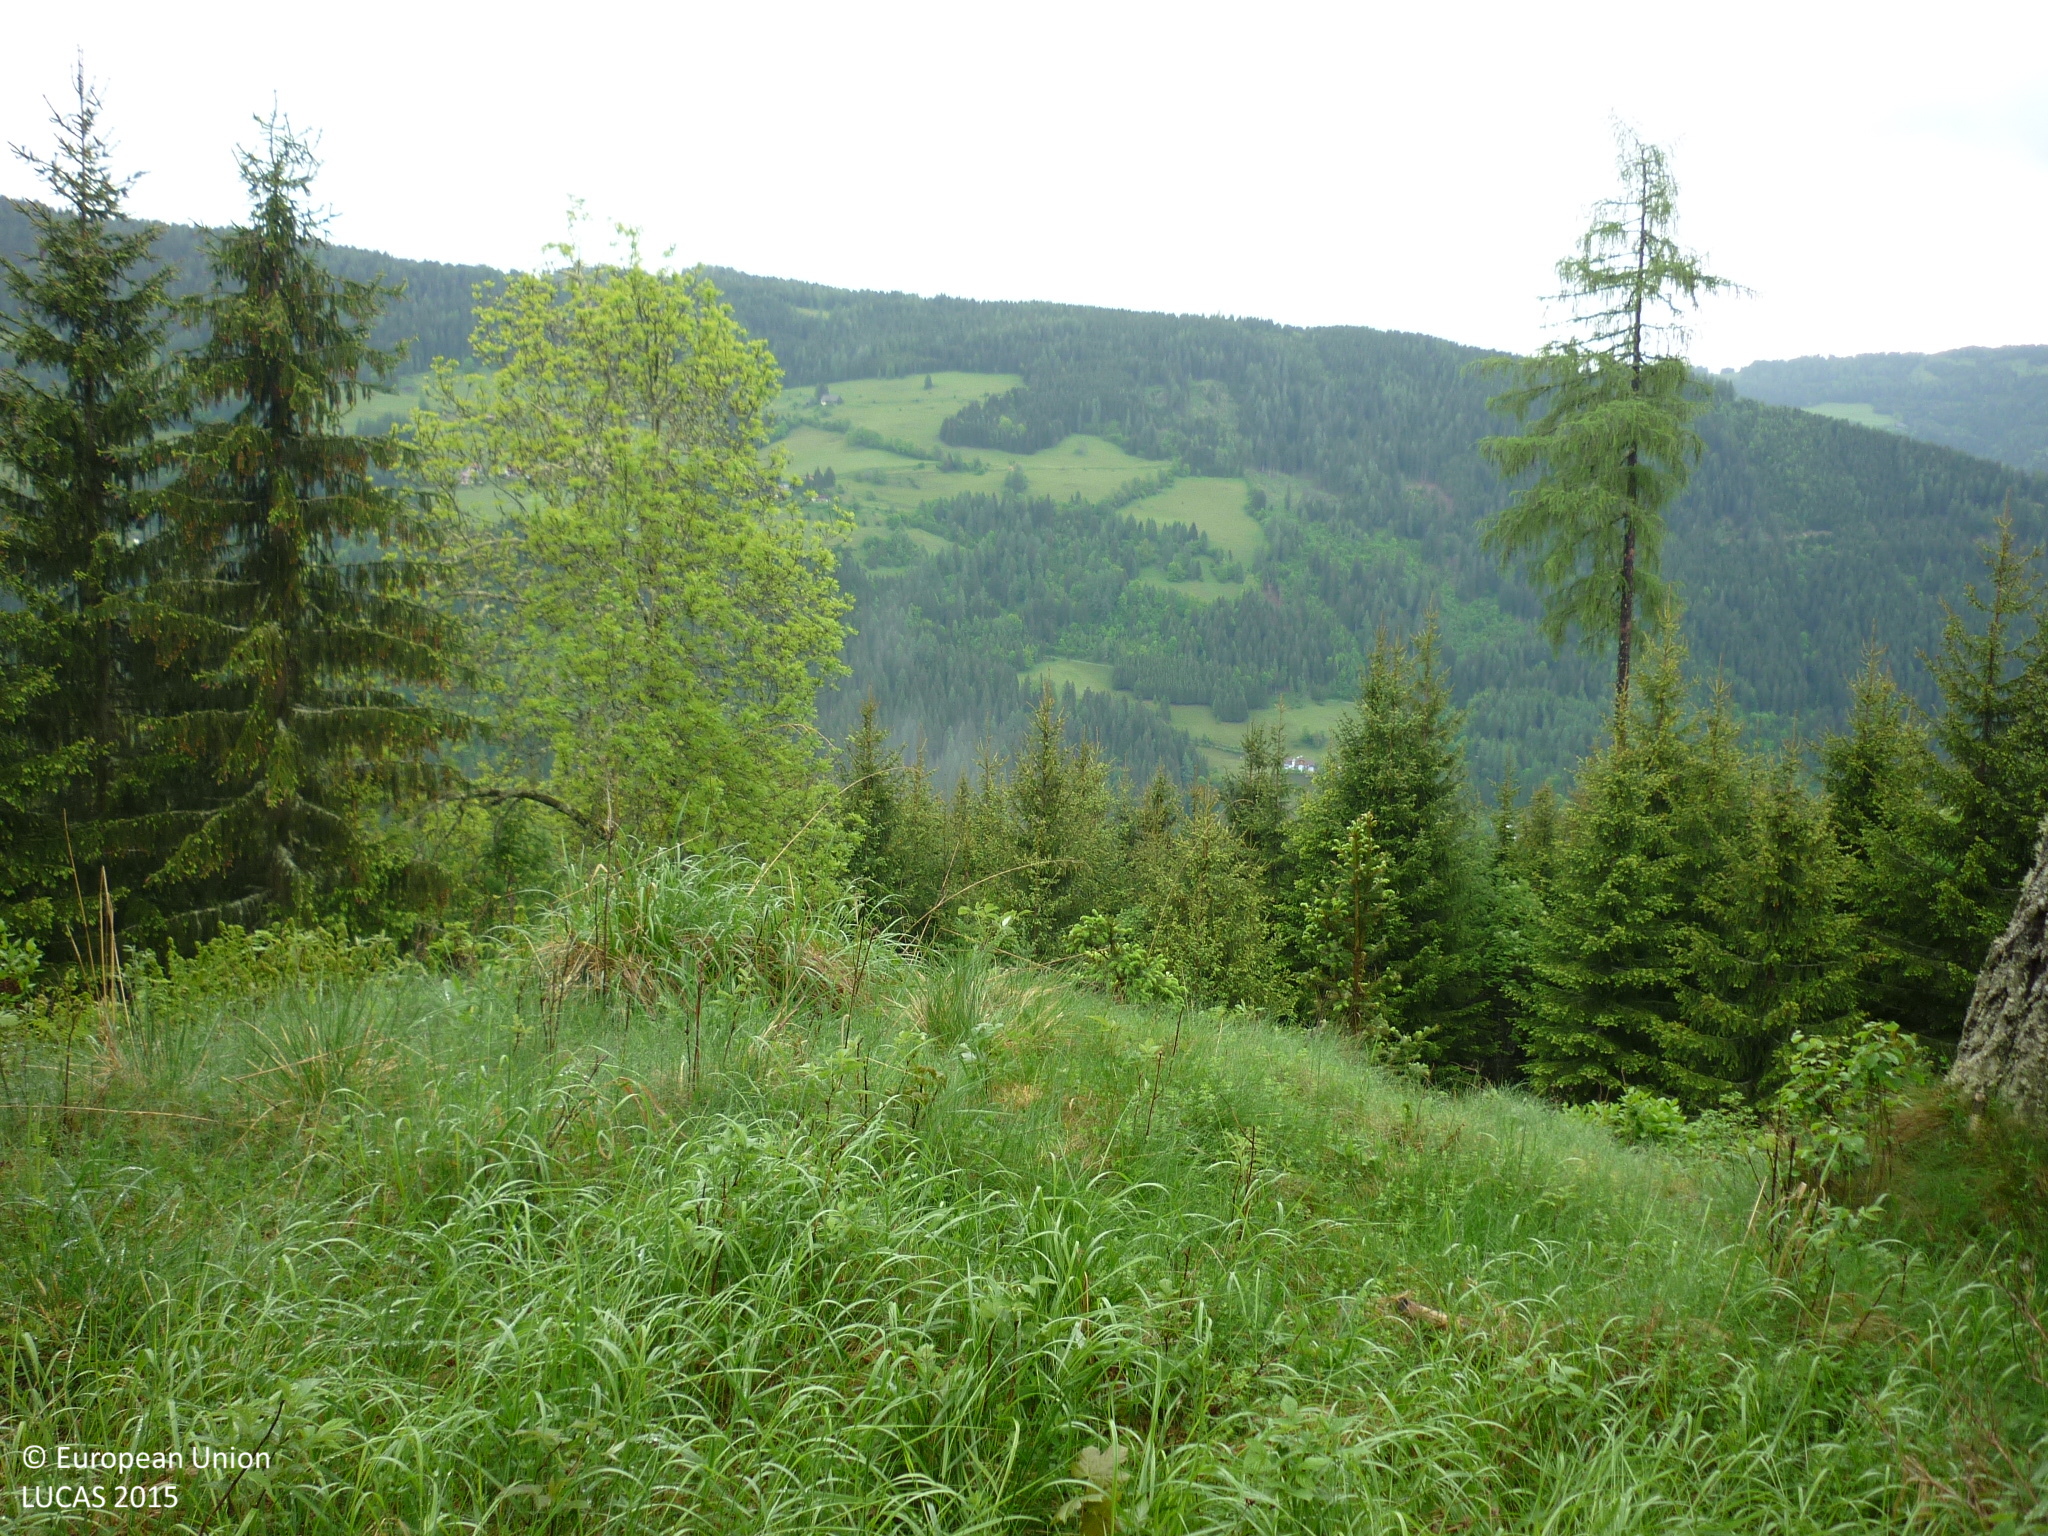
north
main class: Grassland
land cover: Grassland with sparse tree/shrub cover
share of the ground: > 75 %
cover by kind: herbaceous plants 85 %, shrubs 10 %, coniferous forest trees 5 %
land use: Forestry
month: May
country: AT
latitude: 47.1002
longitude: 14.1485
